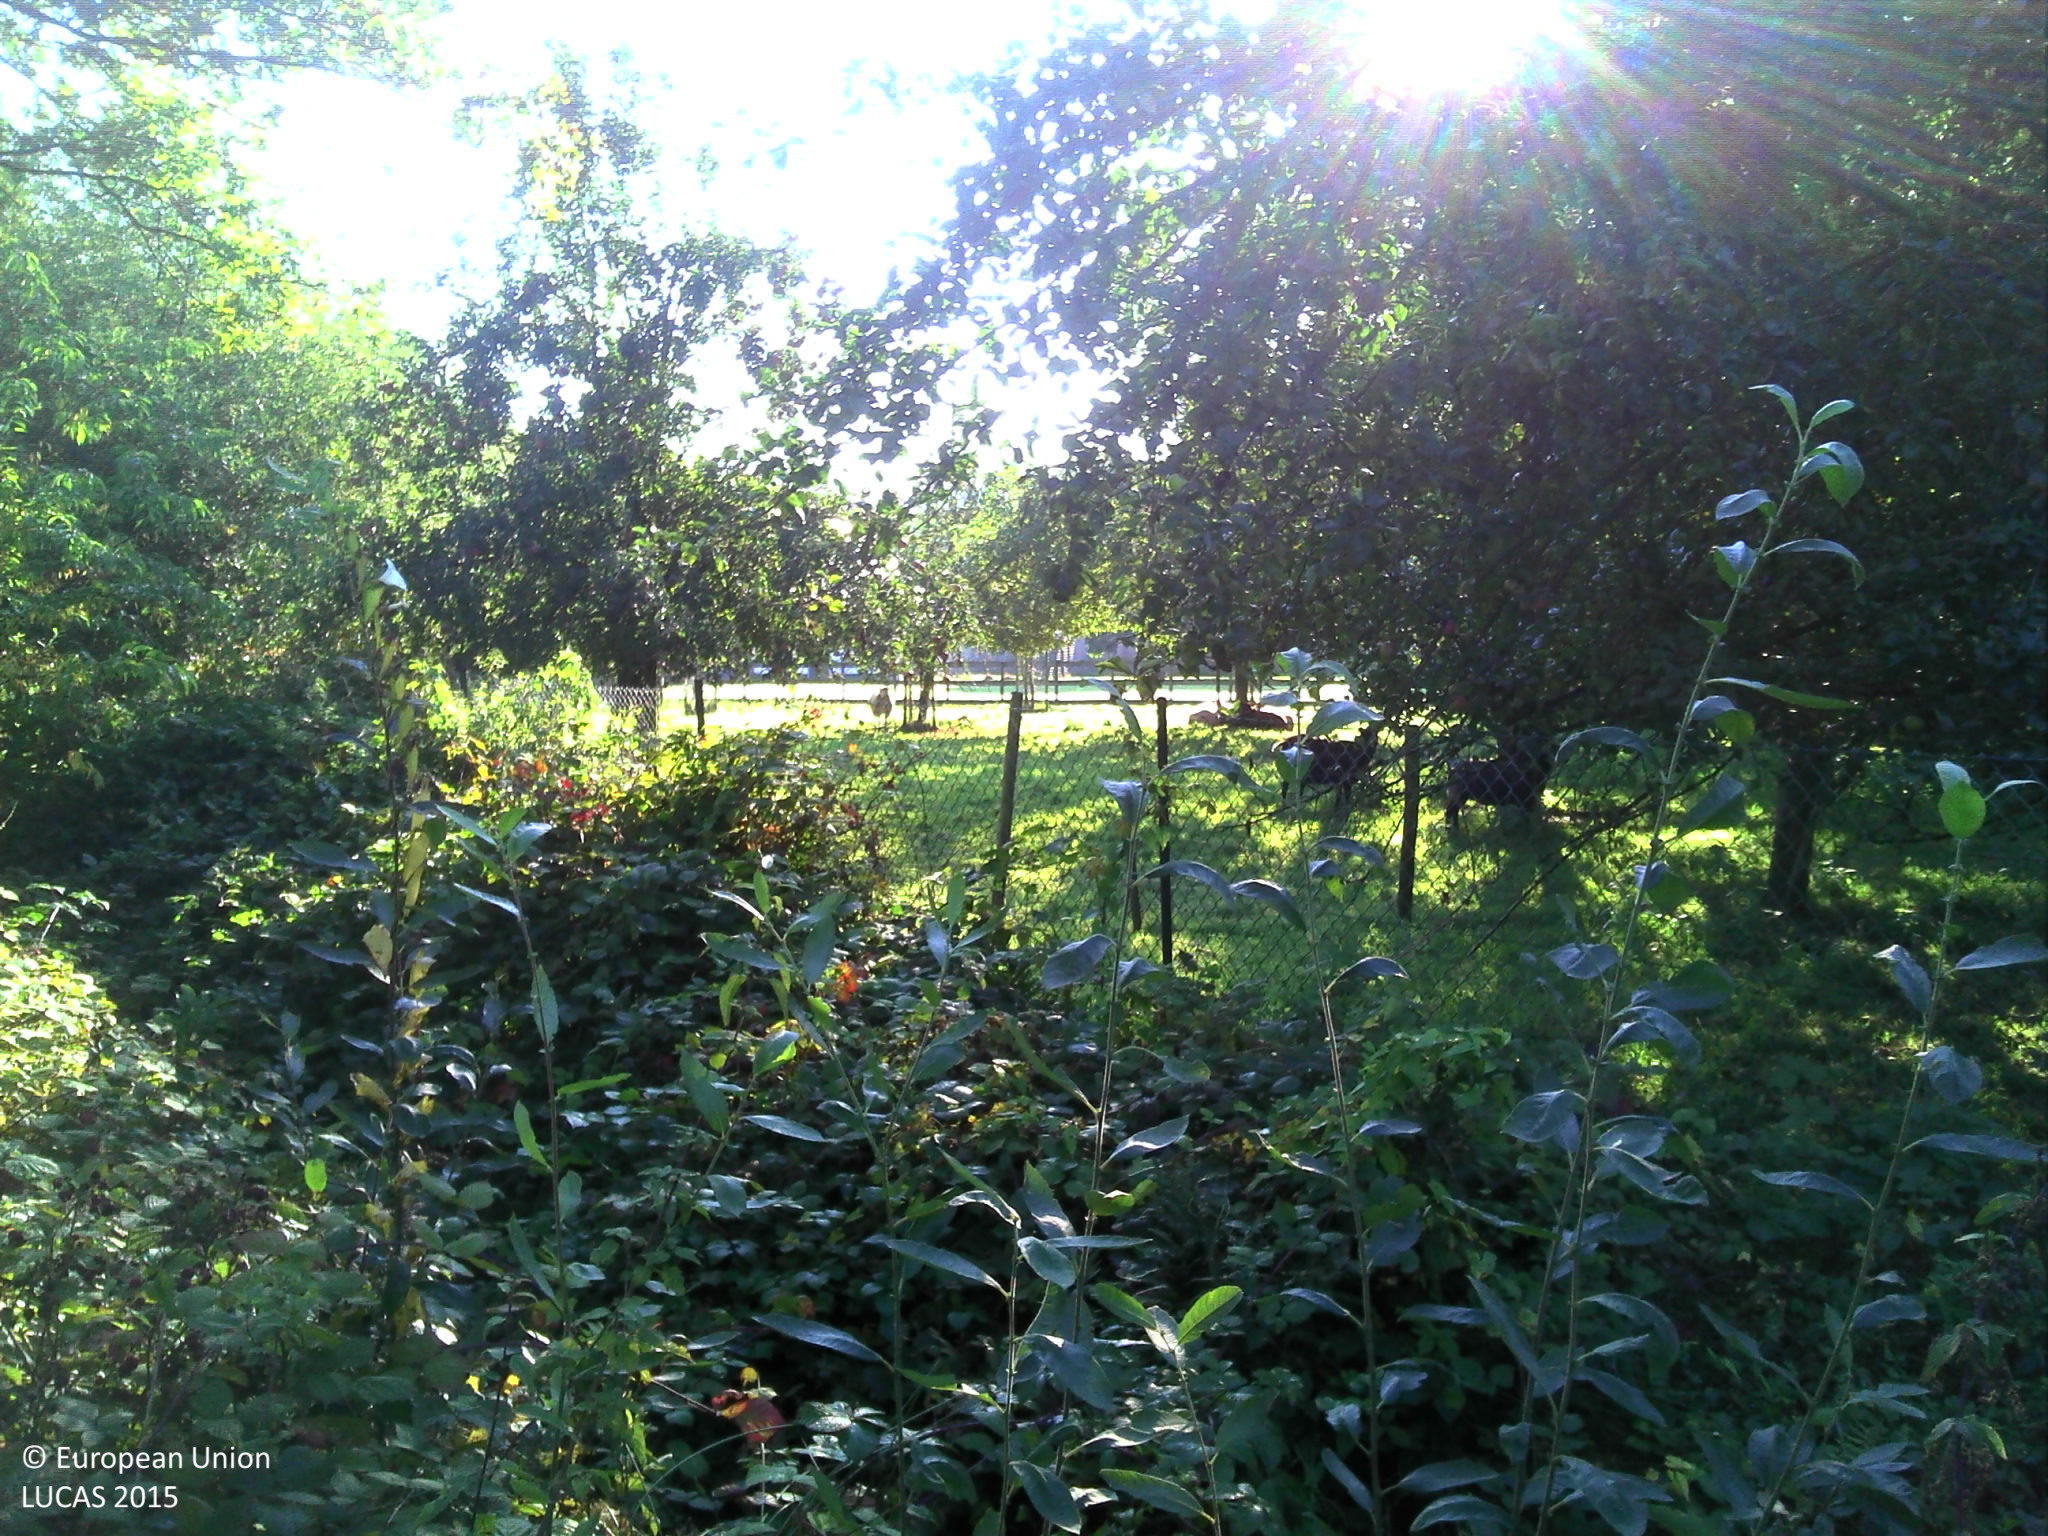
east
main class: Cropland
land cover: Apple fruit
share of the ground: > 75 %
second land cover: Grassland without tree/shrub cover
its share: > 75 %
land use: Agriculture (excluding fallow land and kitchen gardens)
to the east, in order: Apple fruit; Grassland without tree/shrub cover; Artificial constructions in urban areas; Ditches and canals; Grassland without tree/shrub cover; Paved roads, cycling and walking lanes; Lines of trees; Ditches and canals; Other mixed woodland; Ditches and canals; Broadleaved woodland; Fences; Maize
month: September
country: BE
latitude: 51.1943
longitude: 4.6587
